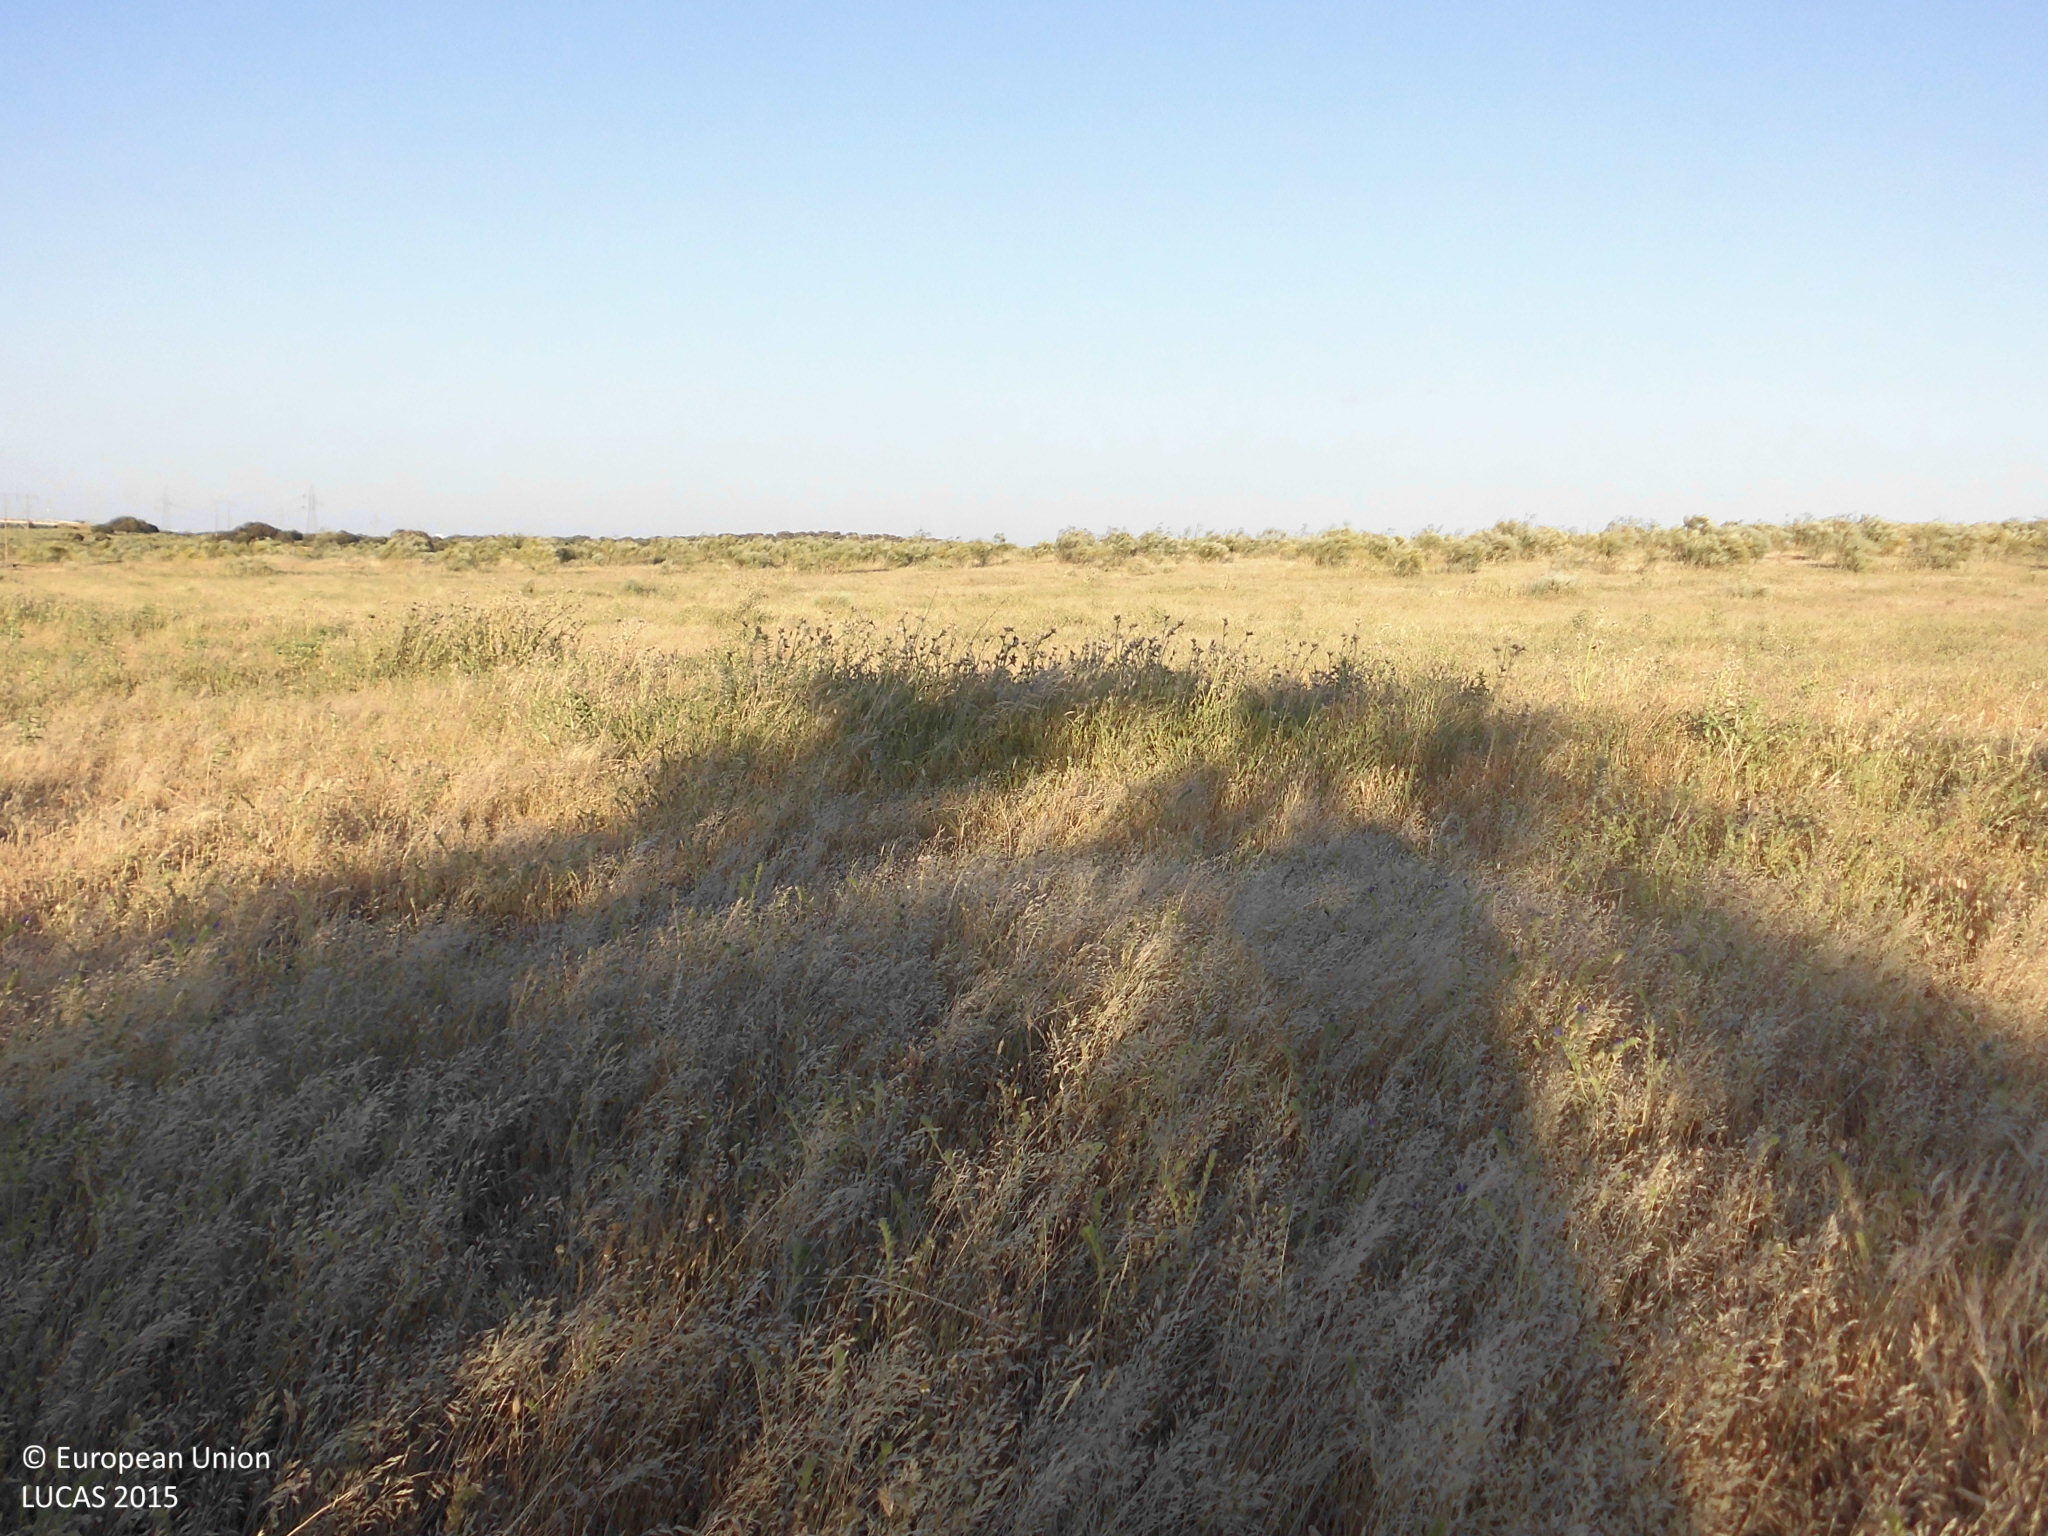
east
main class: Shrubland
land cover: Shrubland without tree cover
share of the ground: 10 - 25 %
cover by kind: herbaceous plants 85 %, shrubs 15 %
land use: Agriculture (excluding fallow land and kitchen gardens)
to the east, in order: Shrubland without tree cover; Grassland without tree/shrub cover; Shrubland without tree cover; Dry stone walls; Grassland without tree/shrub cover
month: May
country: ES
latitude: 39.4394
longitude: -6.0130
